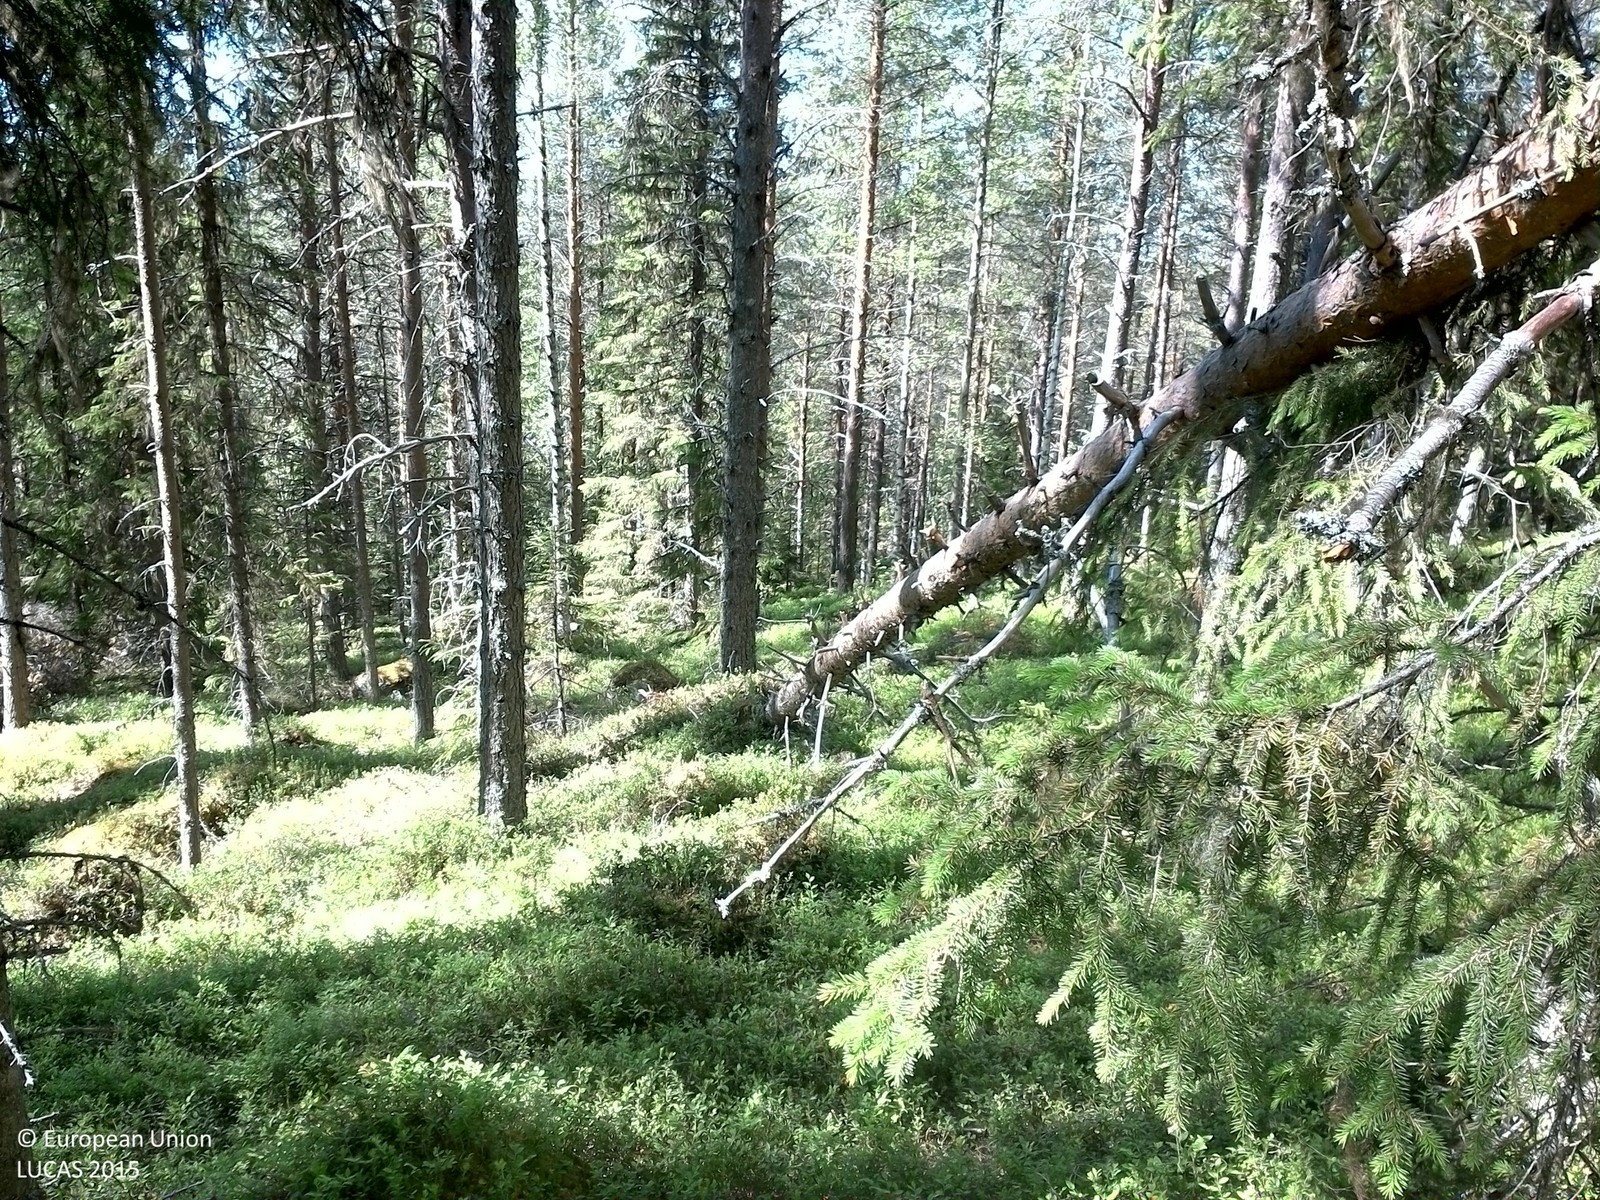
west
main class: Woodland
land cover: Pine dominated coniferous woodland
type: boreal forest
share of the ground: 50 - 75 %
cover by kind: coniferous forest trees 60 %, shrubs 25 %, lichens and mosses 10 %, broadleaved forest trees 5 %
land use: Forestry
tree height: > 5 m
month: July
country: SE
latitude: 64.2327
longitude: 16.8348
